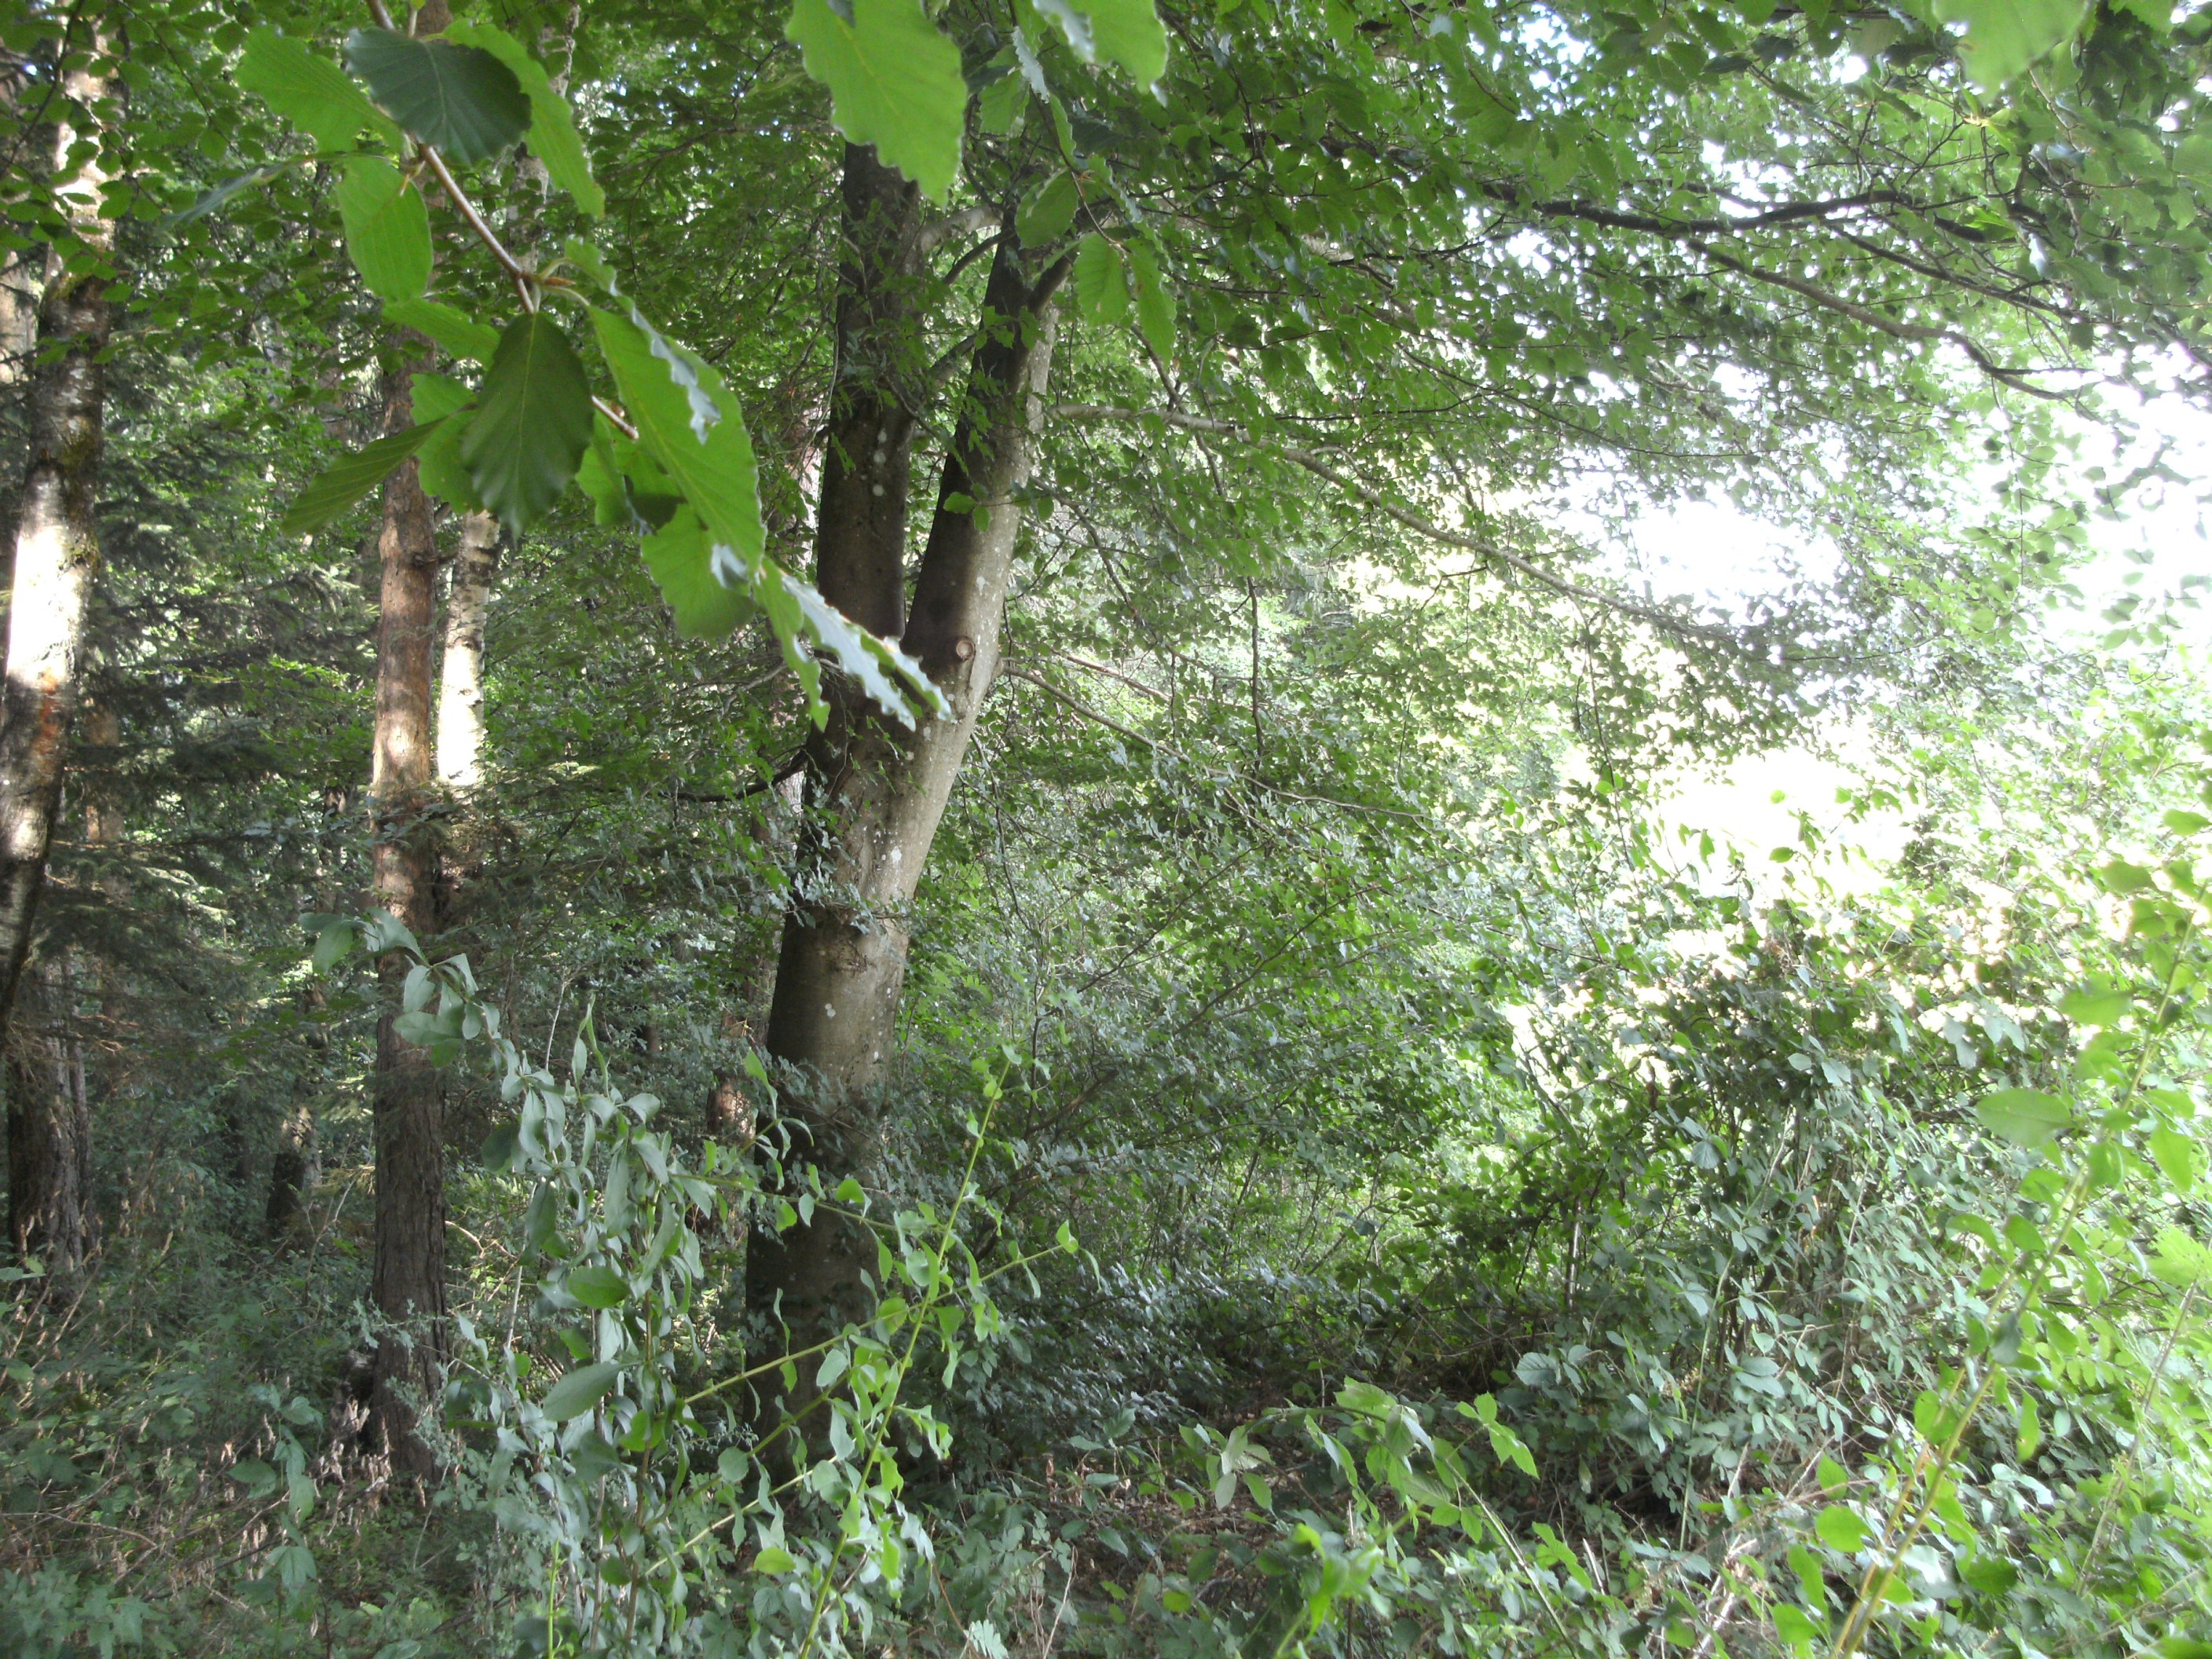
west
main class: Woodland
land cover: Spruce dominated mixed woodland
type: hemiboreal forest and nemoral coniferous forest and mixed broadleaved-coniferous forest
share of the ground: > 75 %
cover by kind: coniferous forest trees 45 %, broadleaved forest trees 45 %, shrubs 5 %, herbaceous plants 5 %
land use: Forestry
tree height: > 5 m
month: July
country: AT
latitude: 46.5600
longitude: 14.5762
